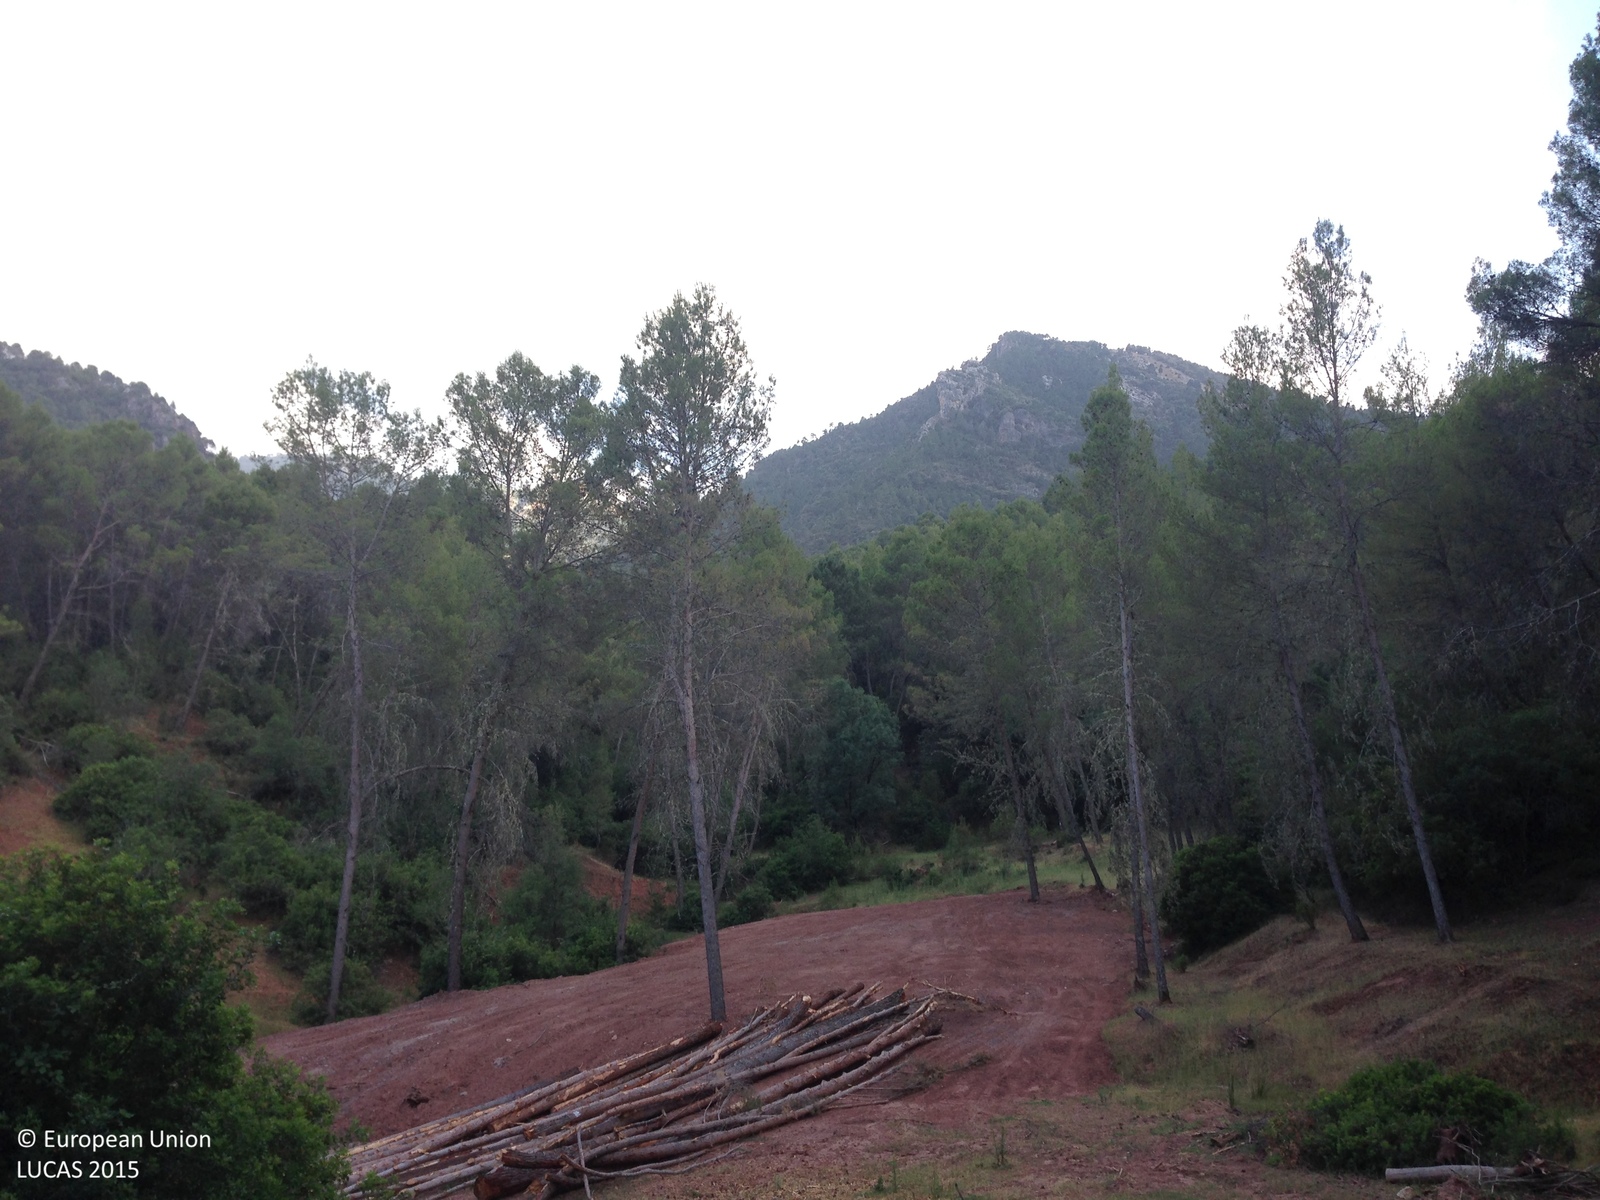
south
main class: Woodland
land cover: Pine dominated coniferous woodland
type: coniferous forest of the mediterranean region
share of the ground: > 75 %
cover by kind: coniferous forest trees 100 %
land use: Forestry
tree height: > 5 m
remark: Clear cut
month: June
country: ES
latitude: 38.0468
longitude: -2.8380
